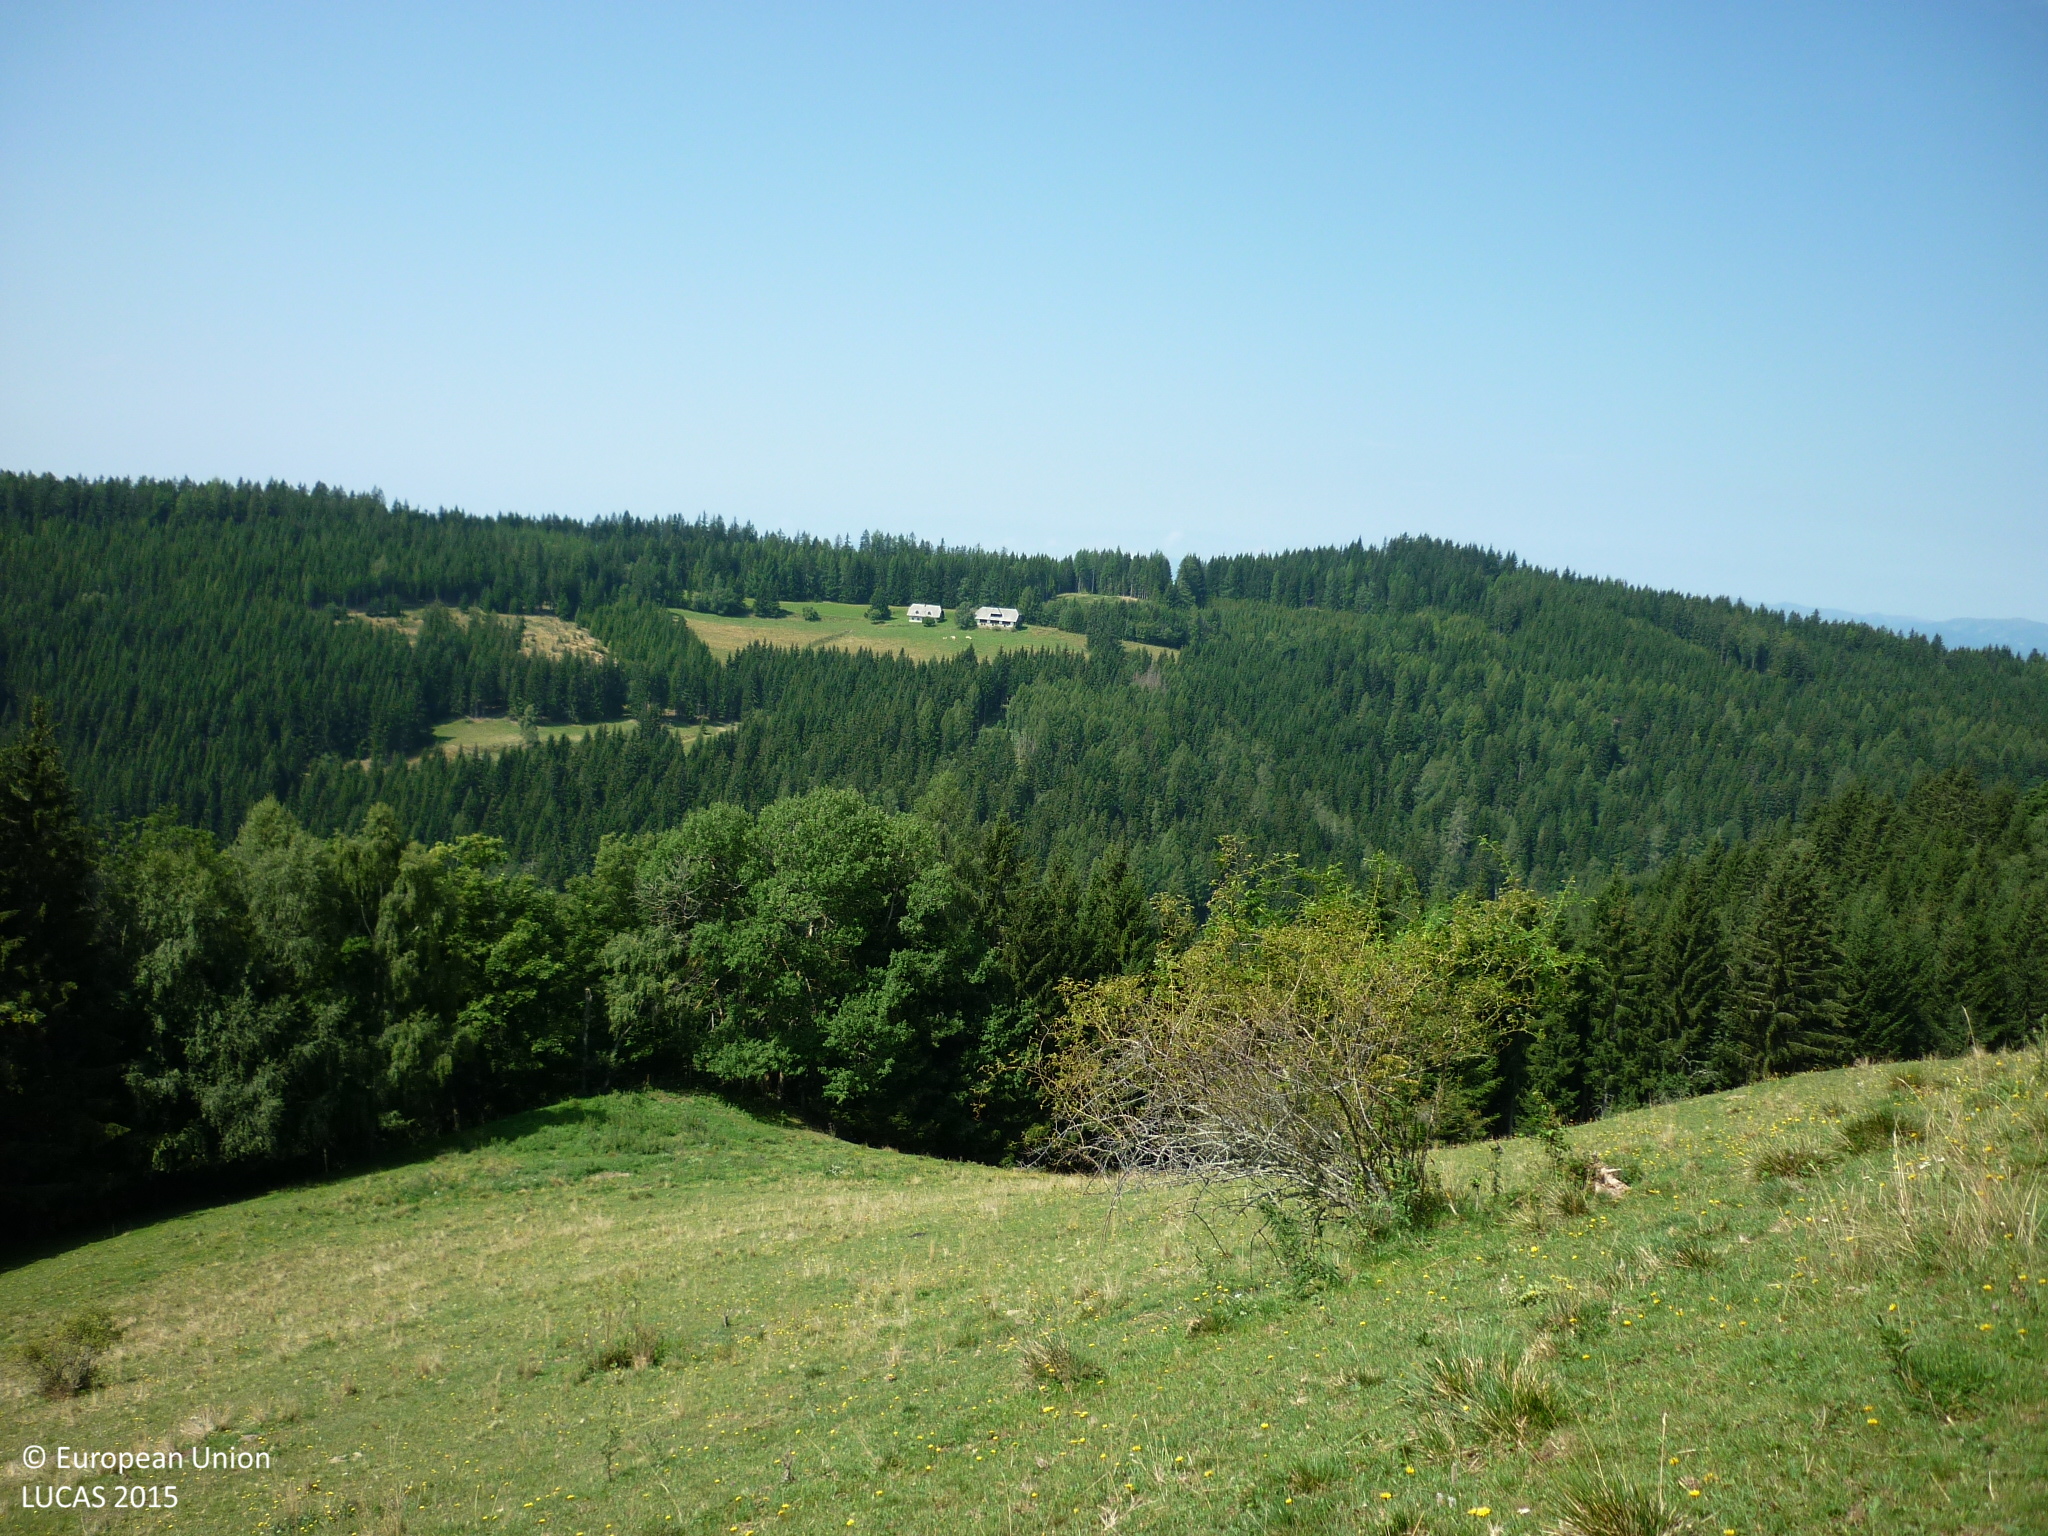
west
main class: Grassland
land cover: Grassland without tree/shrub cover
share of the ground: > 75 %
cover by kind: herbaceous plants 95 %, shrubs 5 %
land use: Agriculture (excluding fallow land and kitchen gardens)
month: August
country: AT
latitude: 46.9248
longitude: 14.4764
